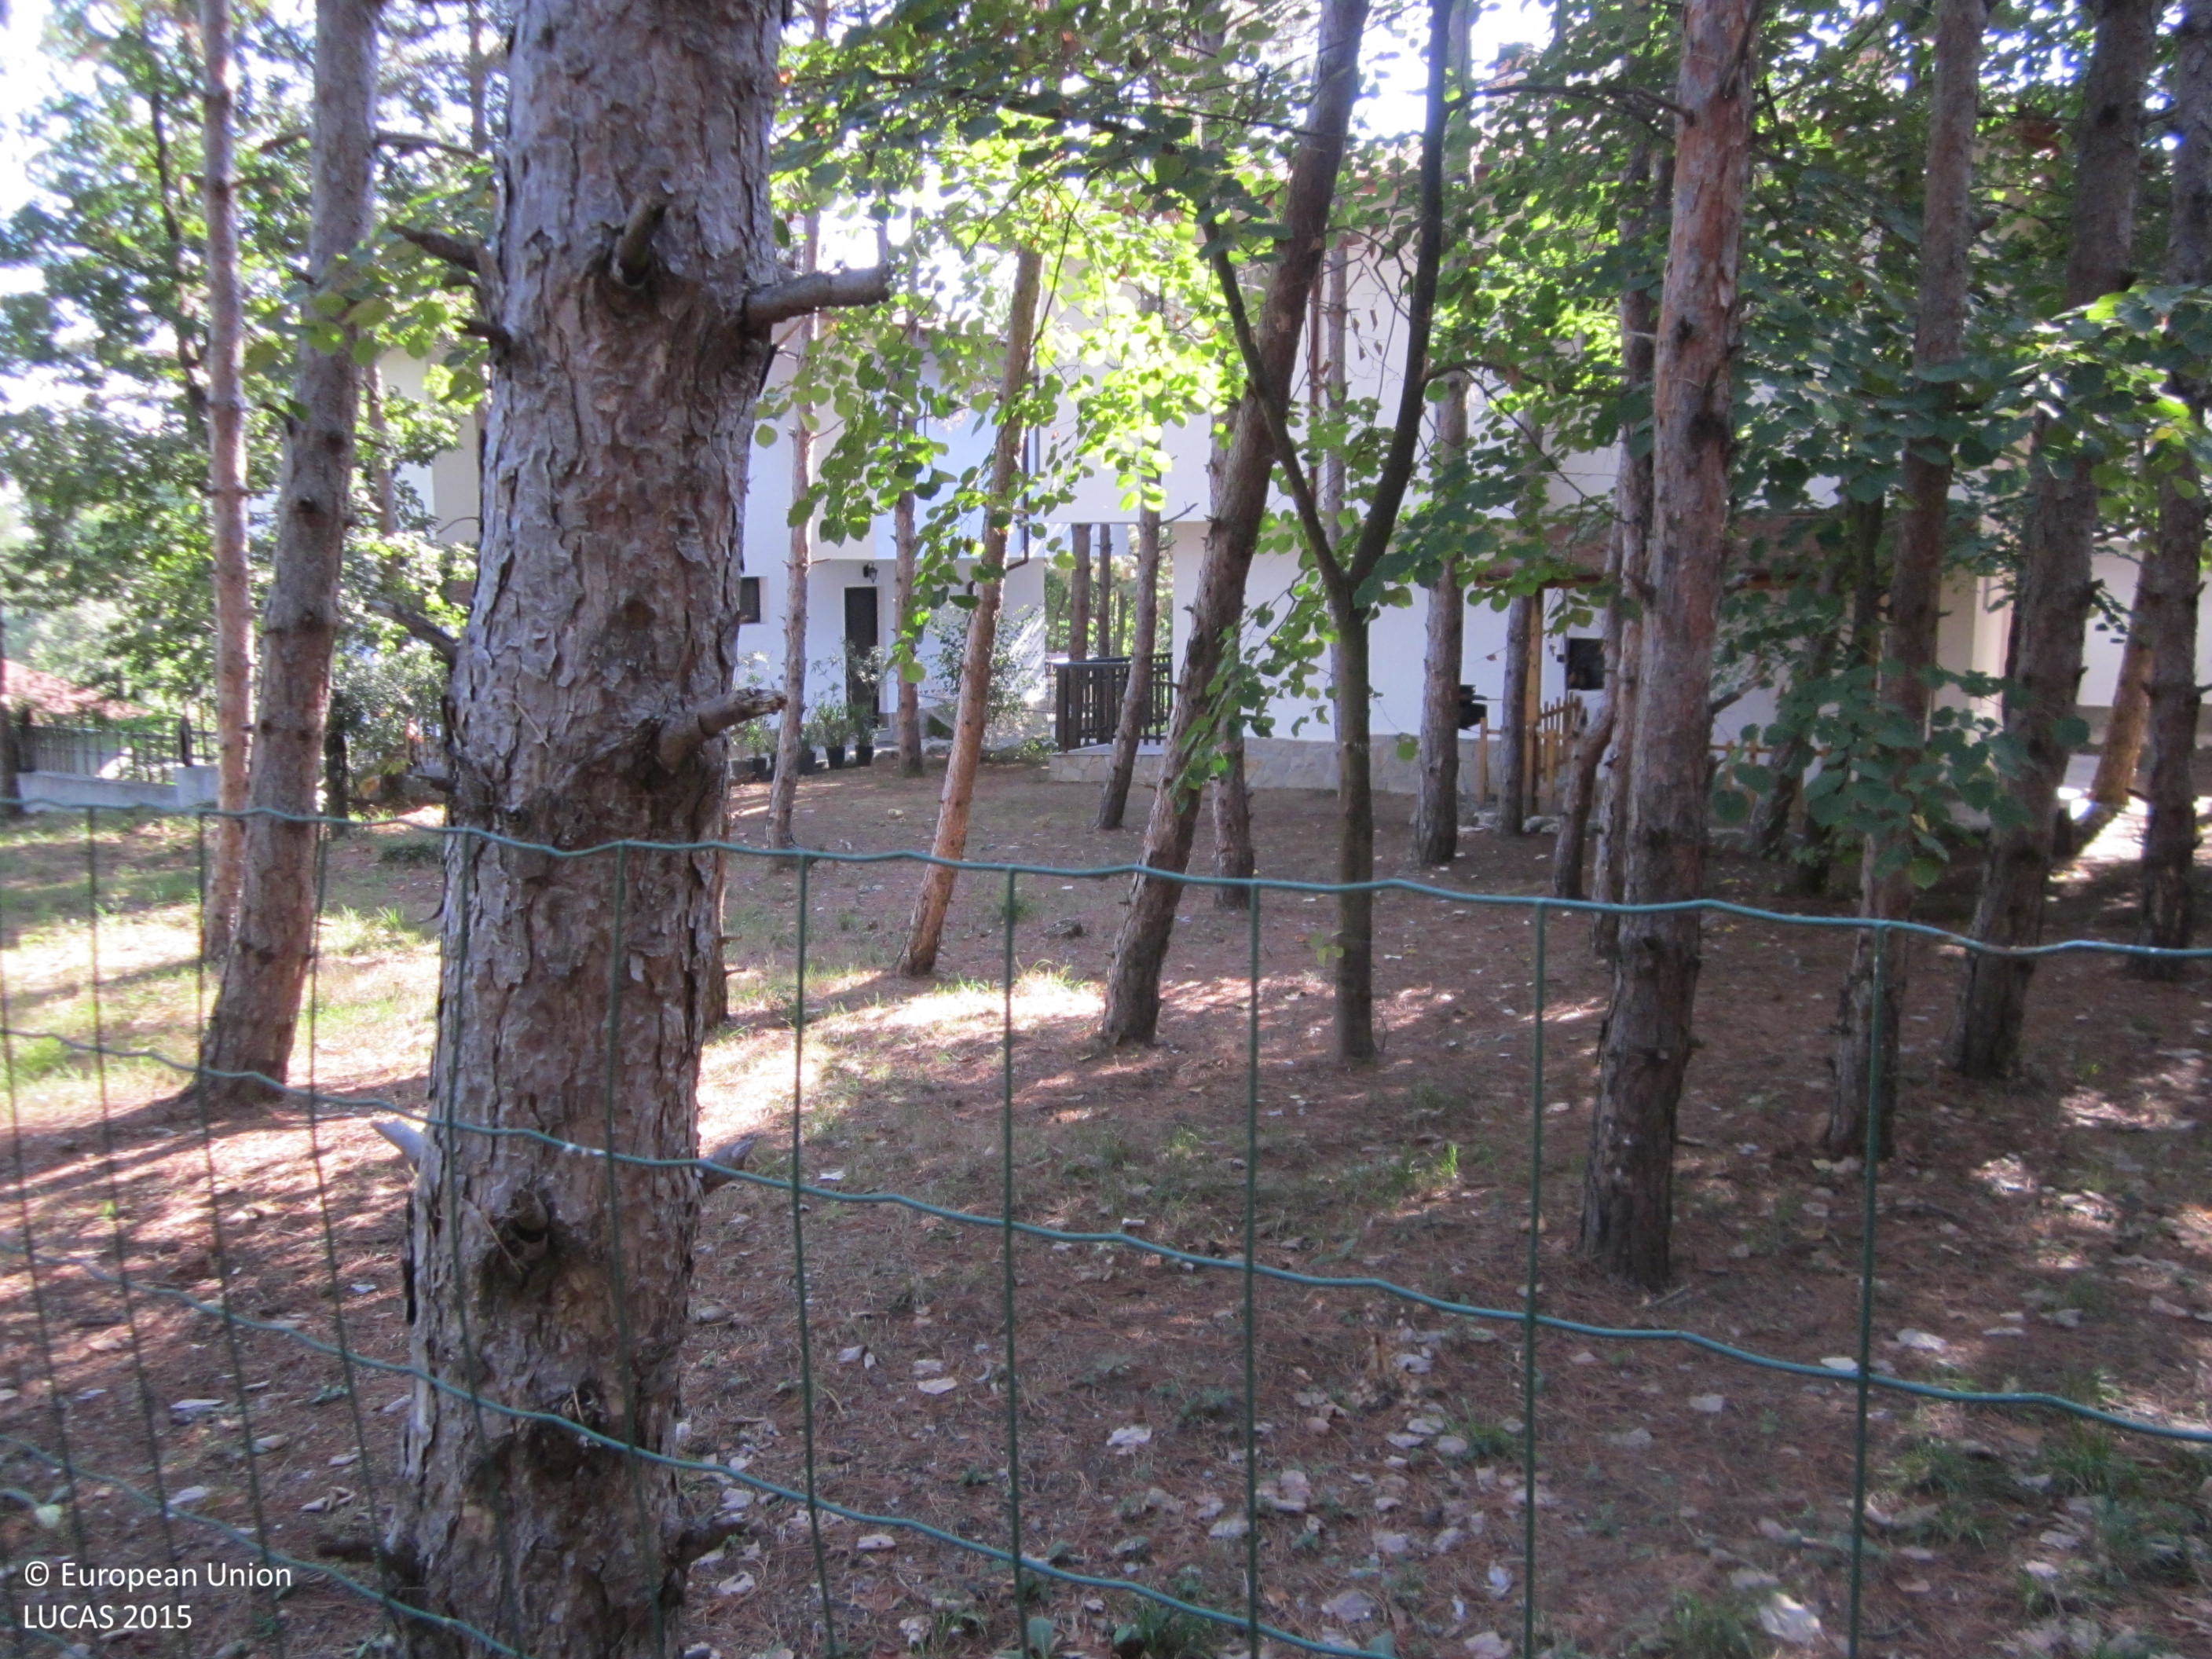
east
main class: Woodland
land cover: Pine dominated mixed woodland
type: acidophilous oak and oak-birch forest
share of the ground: > 75 %
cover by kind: coniferous forest trees 60 %, broadleaved forest trees 20 %, unconsolidated bare surface 20 %
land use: Forestry
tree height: > 5 m
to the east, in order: Pine dominated mixed woodland; Artificial constructions in urban areas; Ditches and canals; Broadleaved woodland; Tracks; Grassland without tree/shrub cover
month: September
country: BG
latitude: 42.1813
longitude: 27.8354
